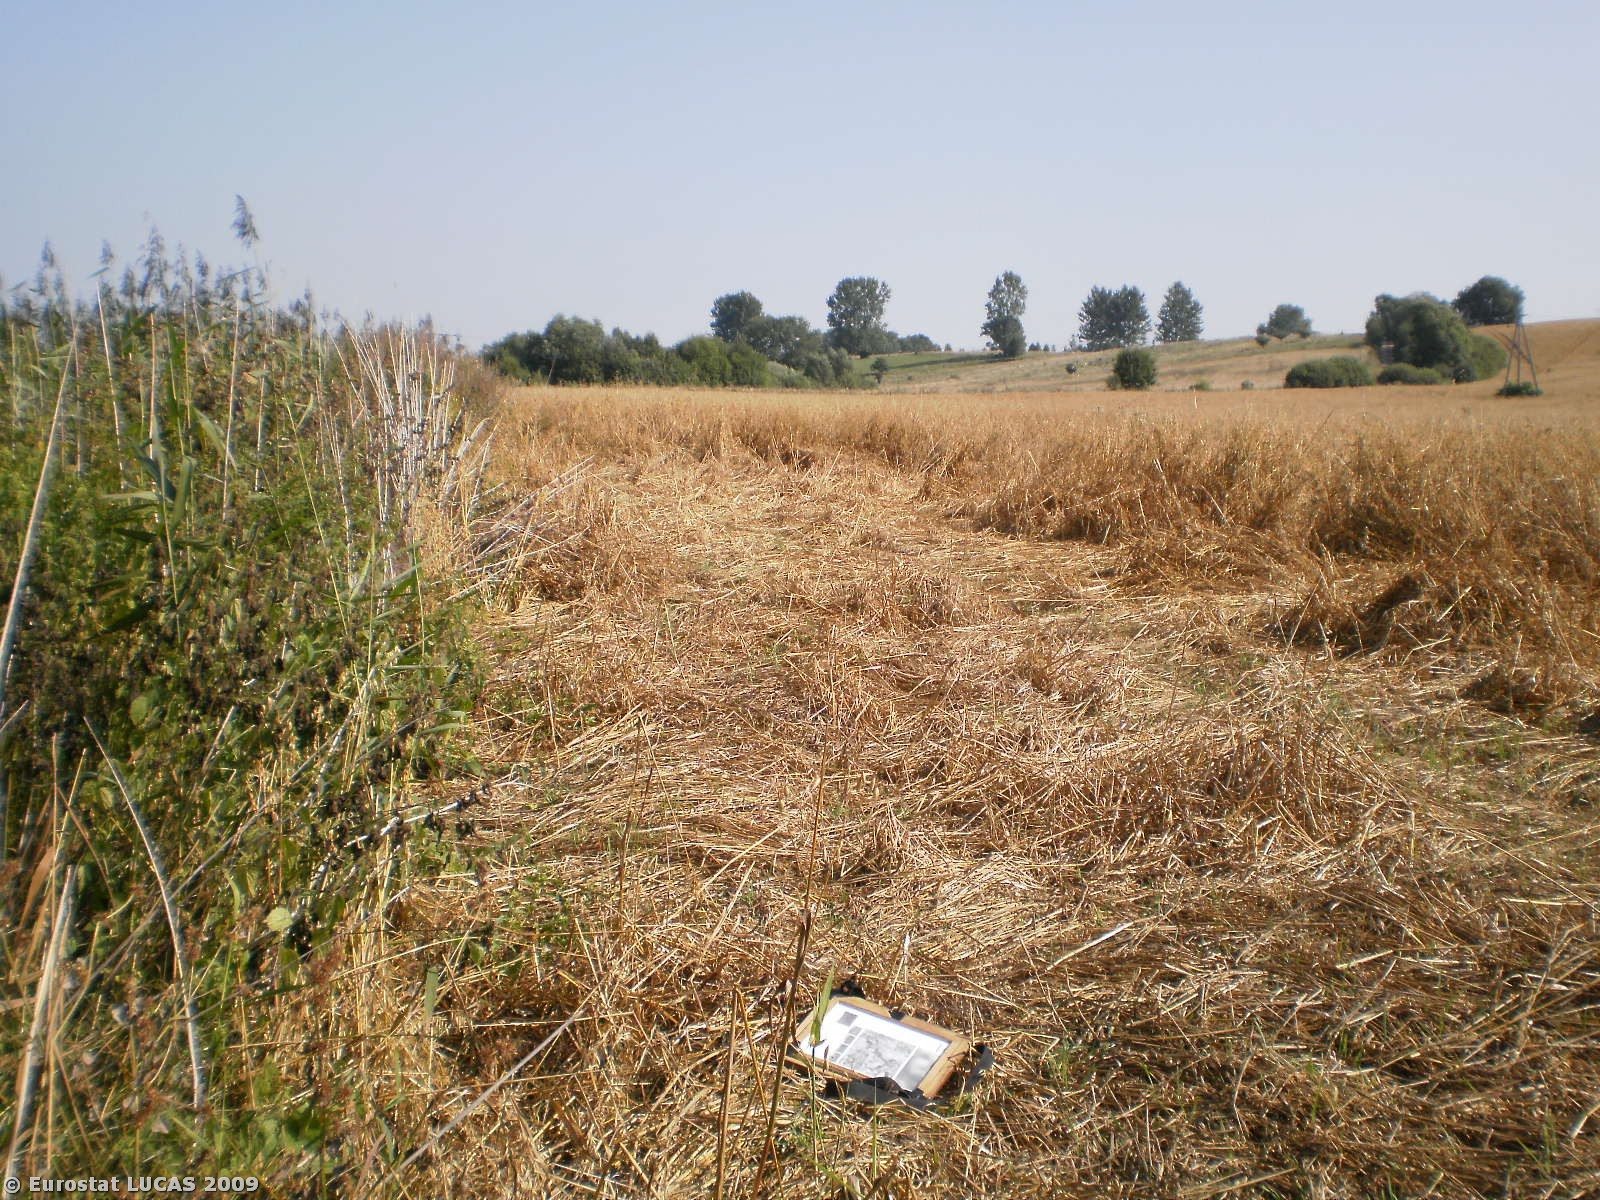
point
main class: Cropland
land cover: Oats
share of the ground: > 75 %
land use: Agriculture (excluding fallow land and kitchen gardens)
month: August
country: PL
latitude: 54.3033
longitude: 21.7160
